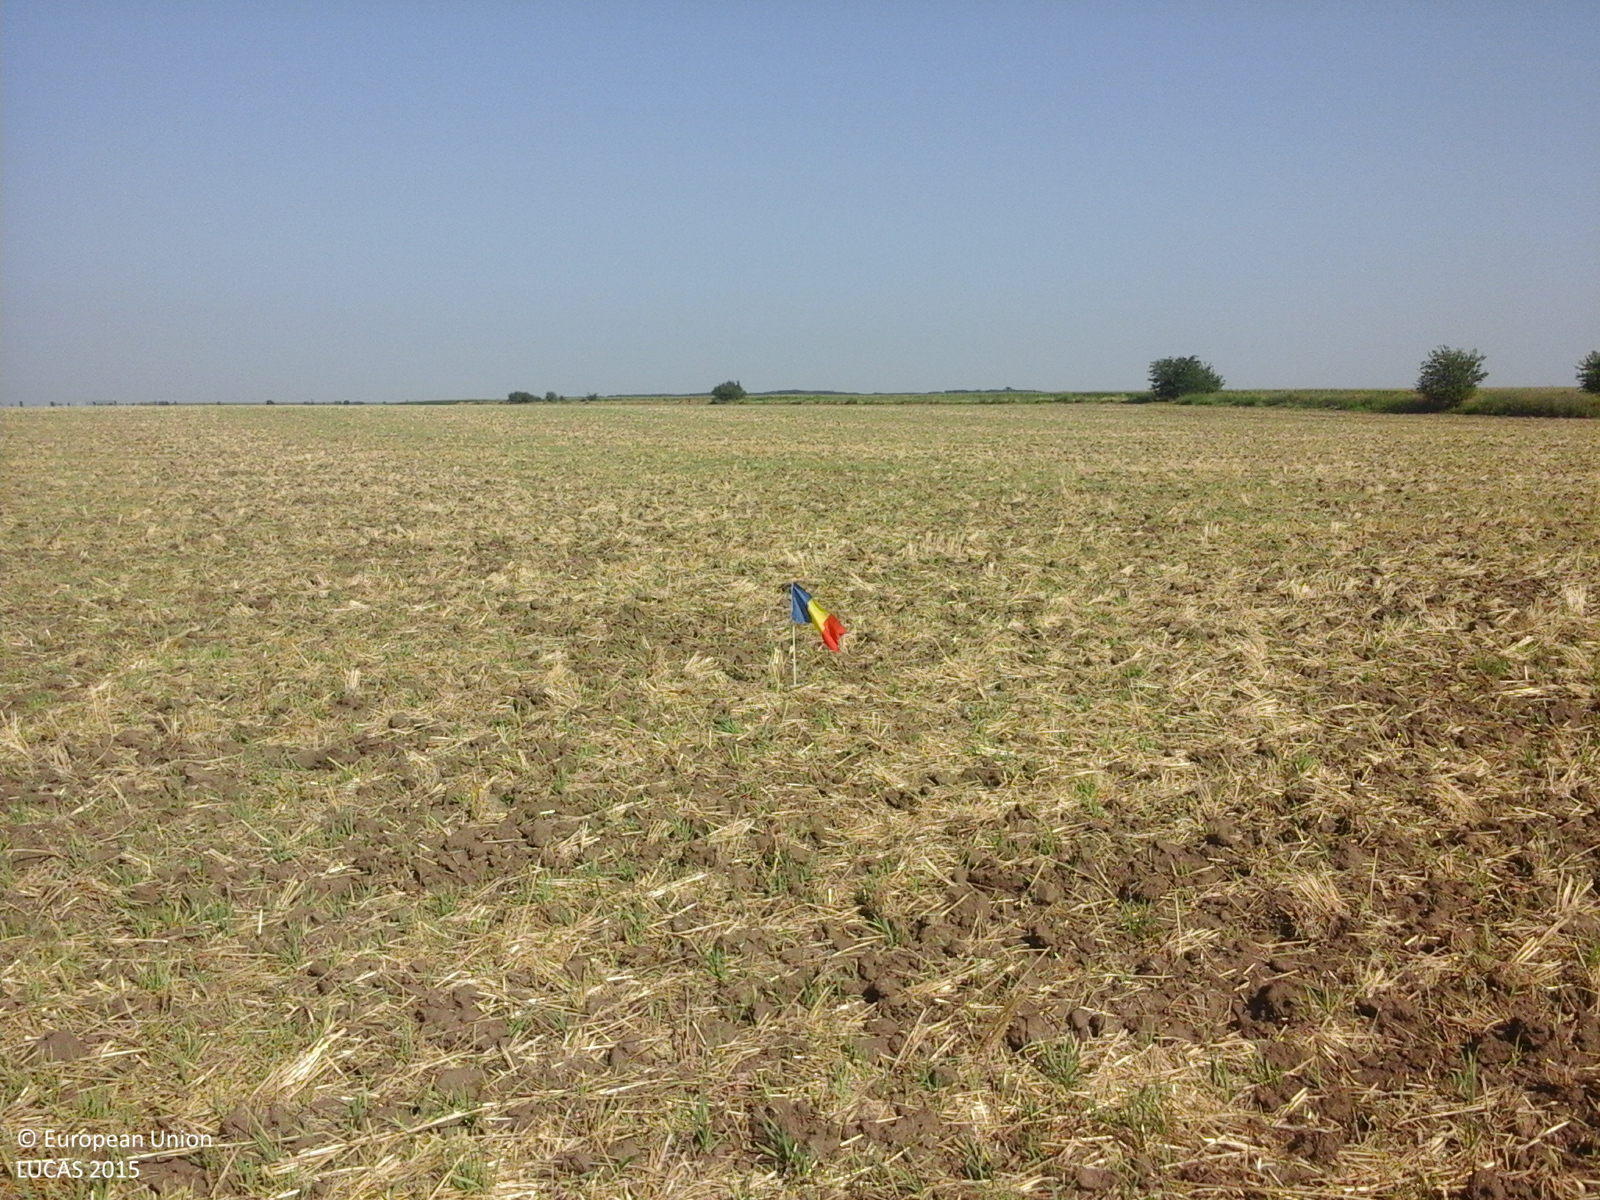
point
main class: Cropland
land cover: Common wheat
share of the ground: 10 - 25 %
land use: Agriculture (excluding fallow land and kitchen gardens)
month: July
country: RO
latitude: 44.3922
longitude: 27.0904
